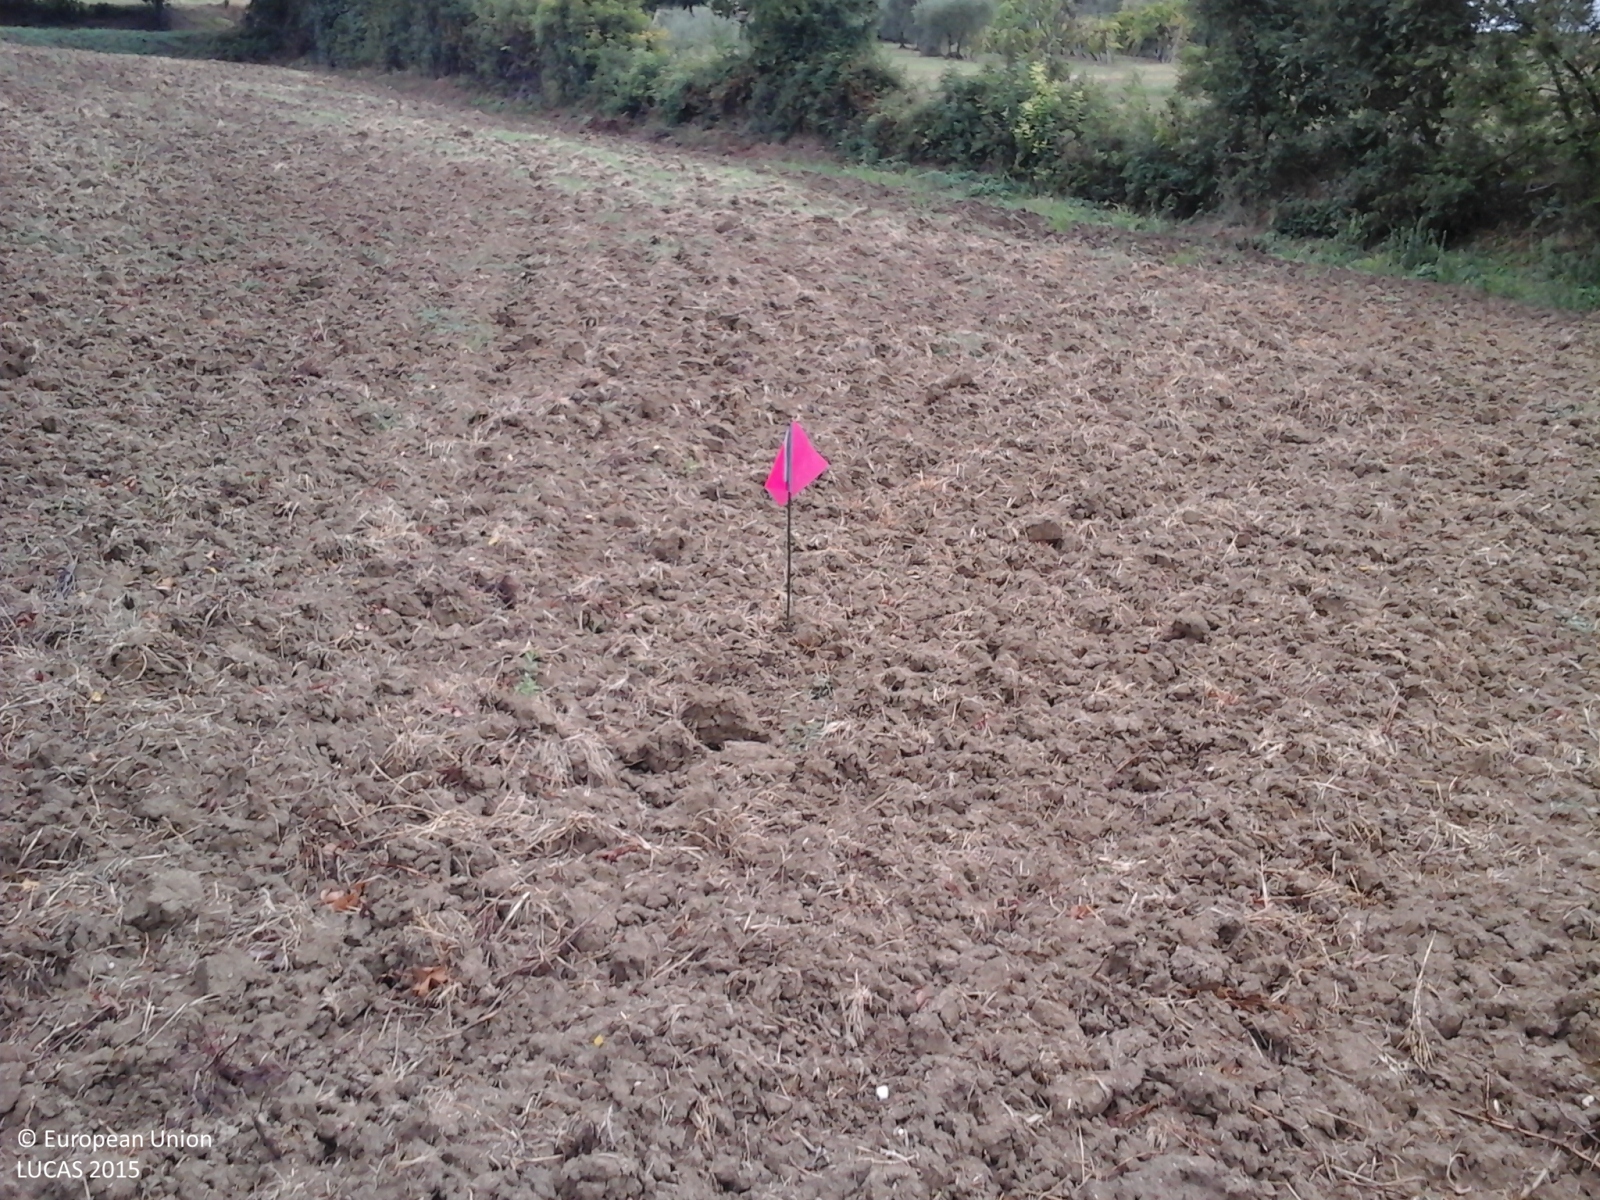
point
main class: Cropland
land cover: Durum wheat
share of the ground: < 10 %
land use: Agriculture (excluding fallow land and kitchen gardens)
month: August
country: IT
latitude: 43.6384
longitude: 13.0296
